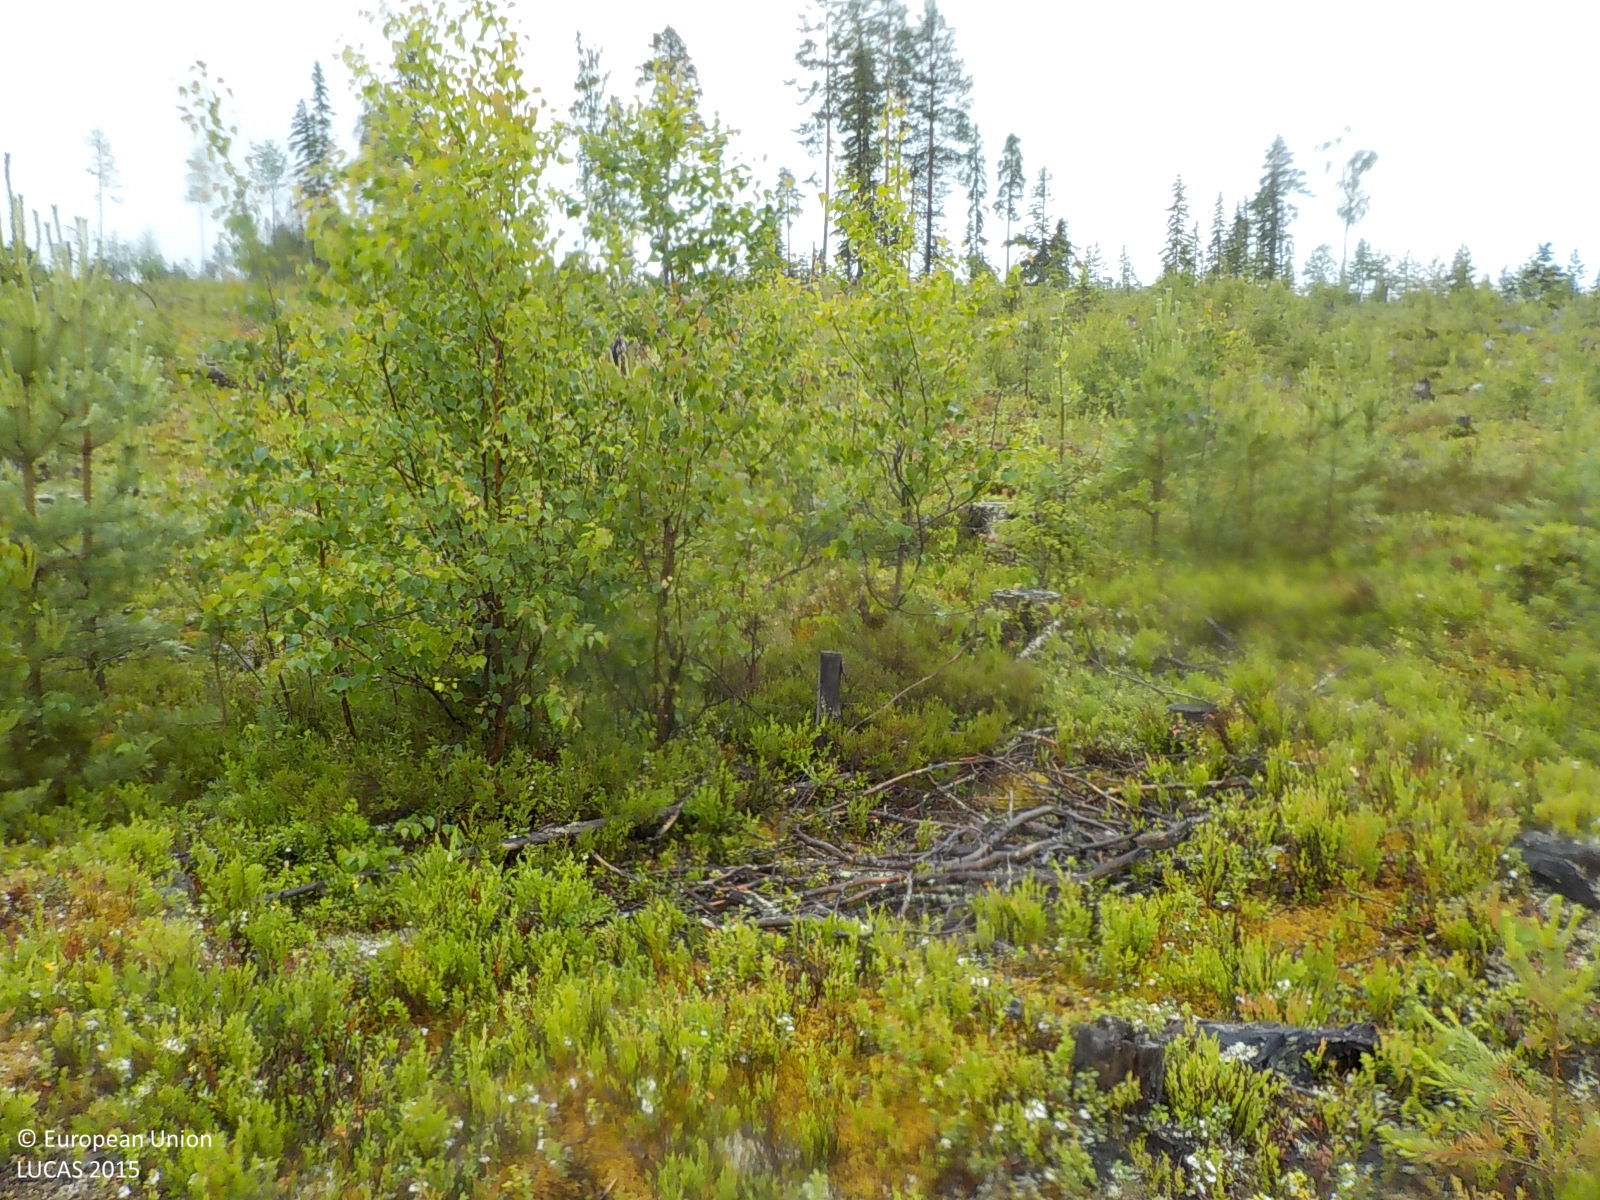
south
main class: Woodland
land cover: Other mixed woodland
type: boreal forest
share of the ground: 50 - 75 %
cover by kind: shrubs 50 %, coniferous forest trees 30 %, broadleaved forest trees 20 %
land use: Forestry
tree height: < 5 m
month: July
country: SE
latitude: 63.0116
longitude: 16.9883
